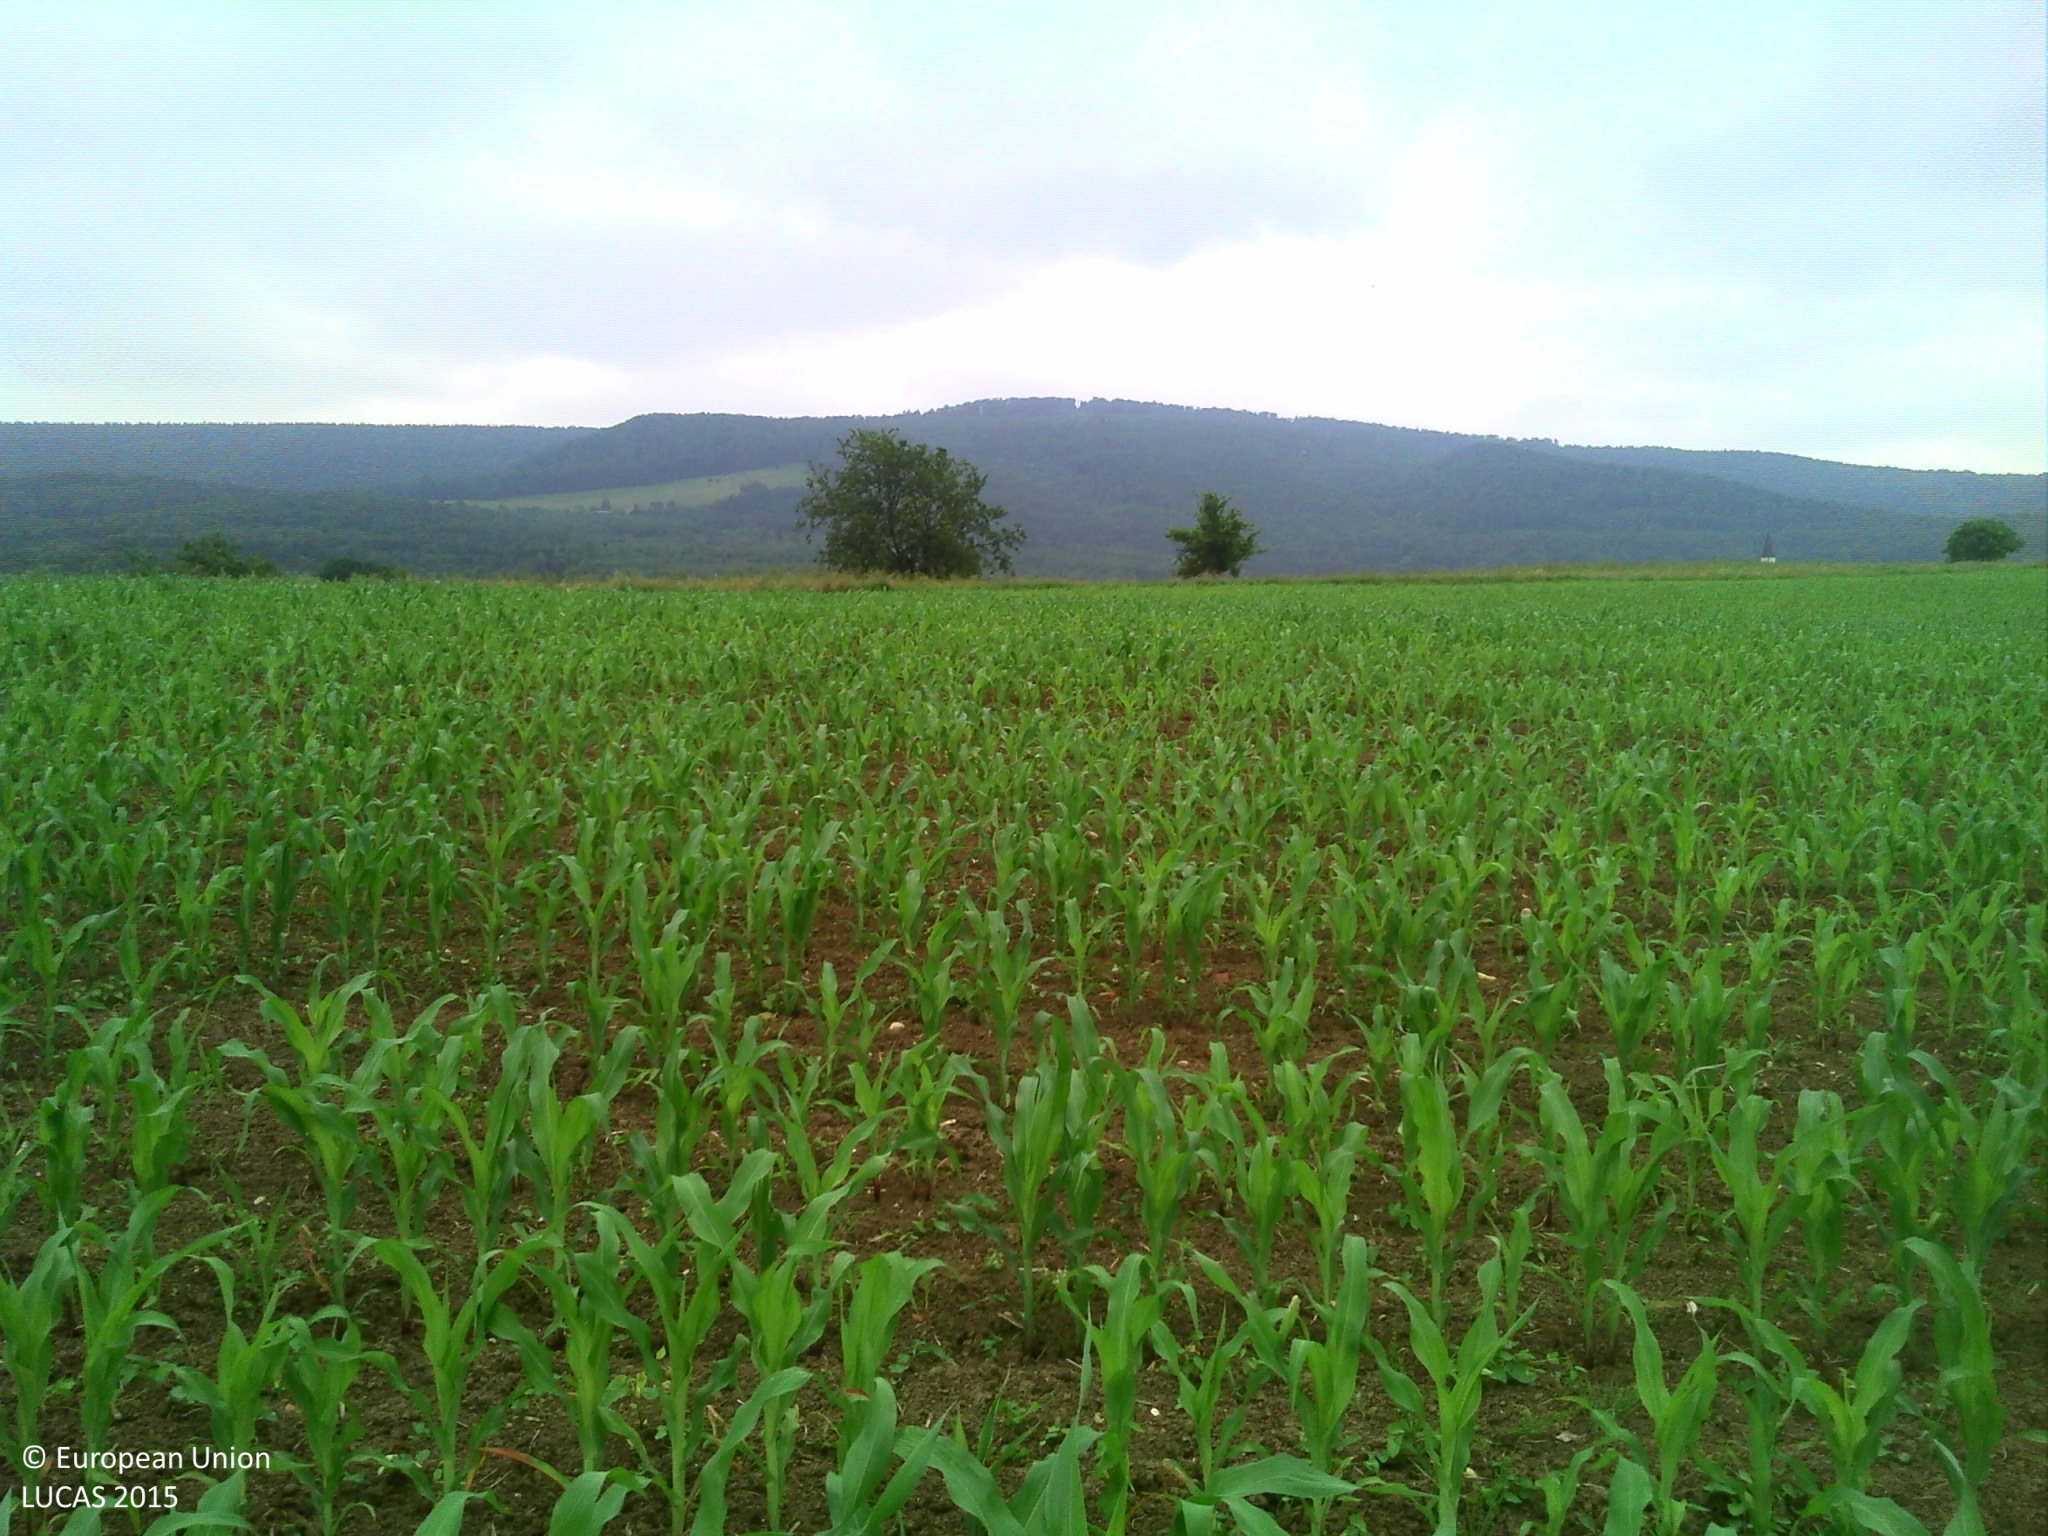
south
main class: Cropland
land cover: Maize
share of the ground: 10 - 25 %
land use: Agriculture (excluding fallow land and kitchen gardens)
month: June
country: FR
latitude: 47.4730
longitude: 7.4144
